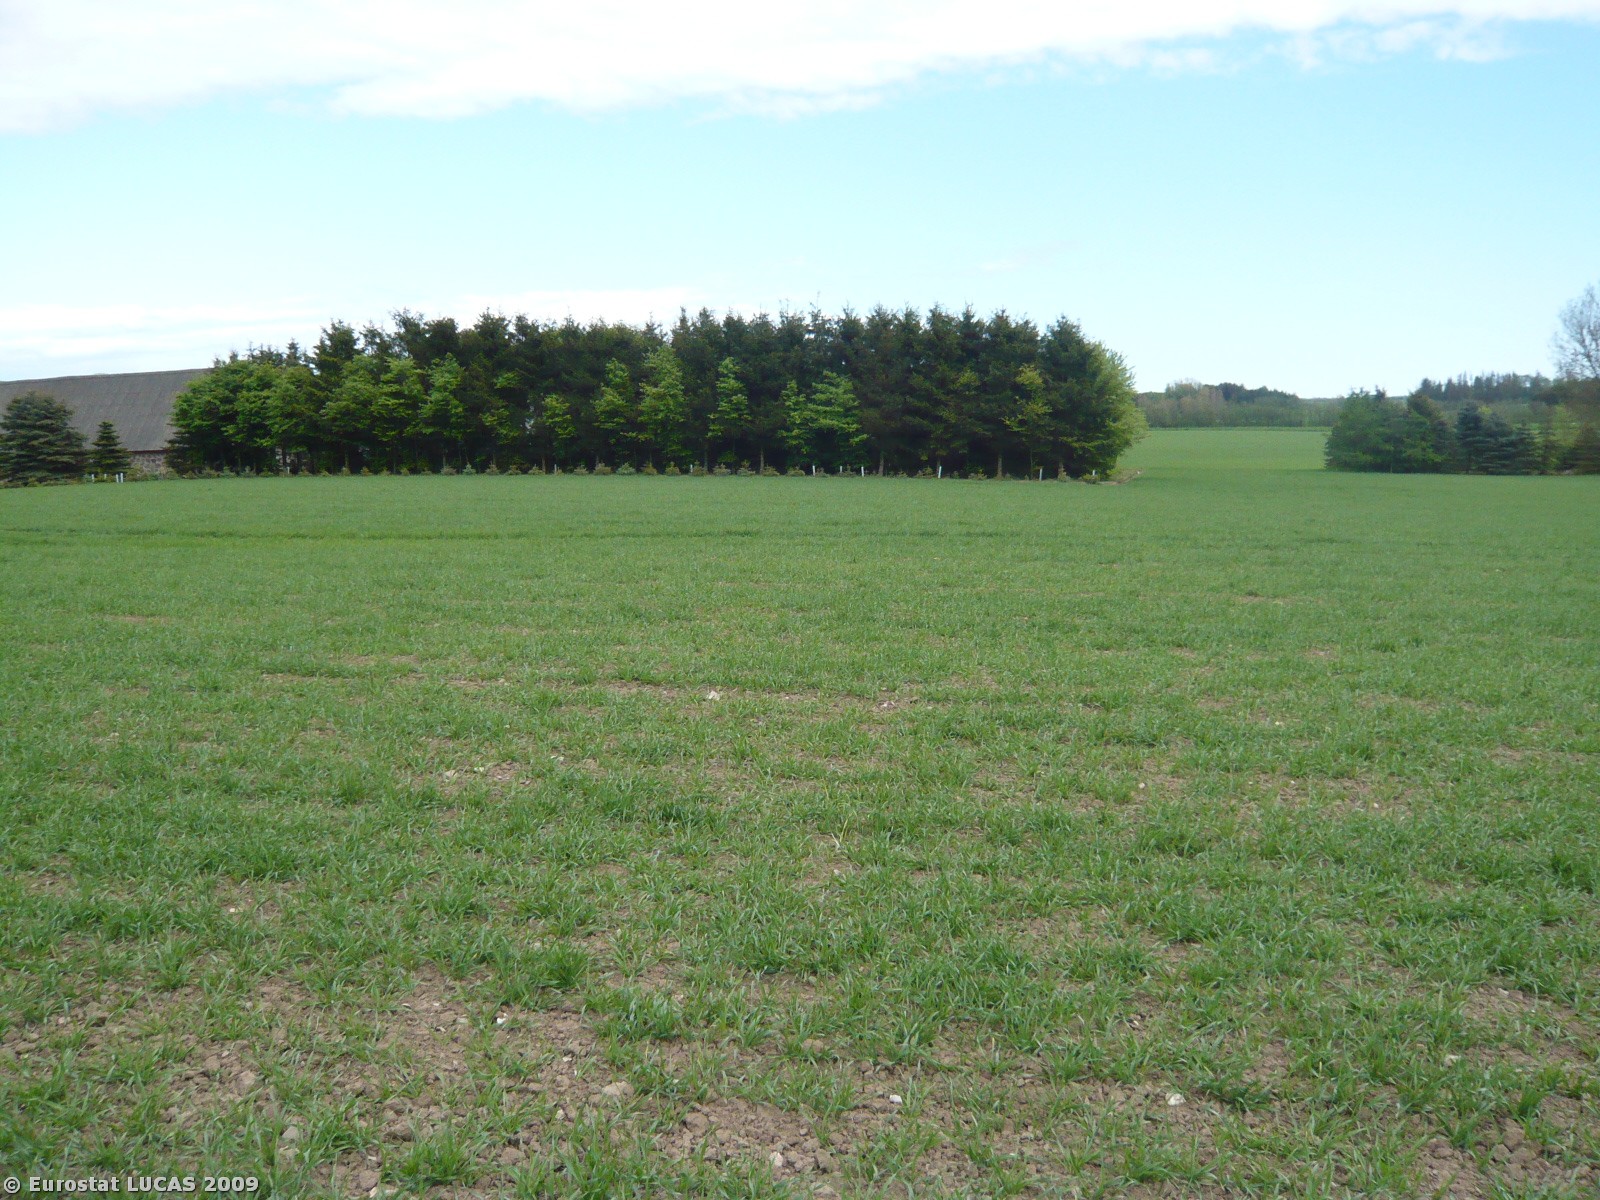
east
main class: Cropland
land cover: Common wheat
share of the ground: 25 - 50 %
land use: Agriculture (excluding fallow land and kitchen gardens)
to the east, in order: Common wheat; Mixed woodland; Grassland without tree/shrub cover; Broadleaved woodland; Common wheat; Lines of trees; Tracks; Lines of trees; Common wheat
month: May
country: DK
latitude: 55.0940
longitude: 11.9573
